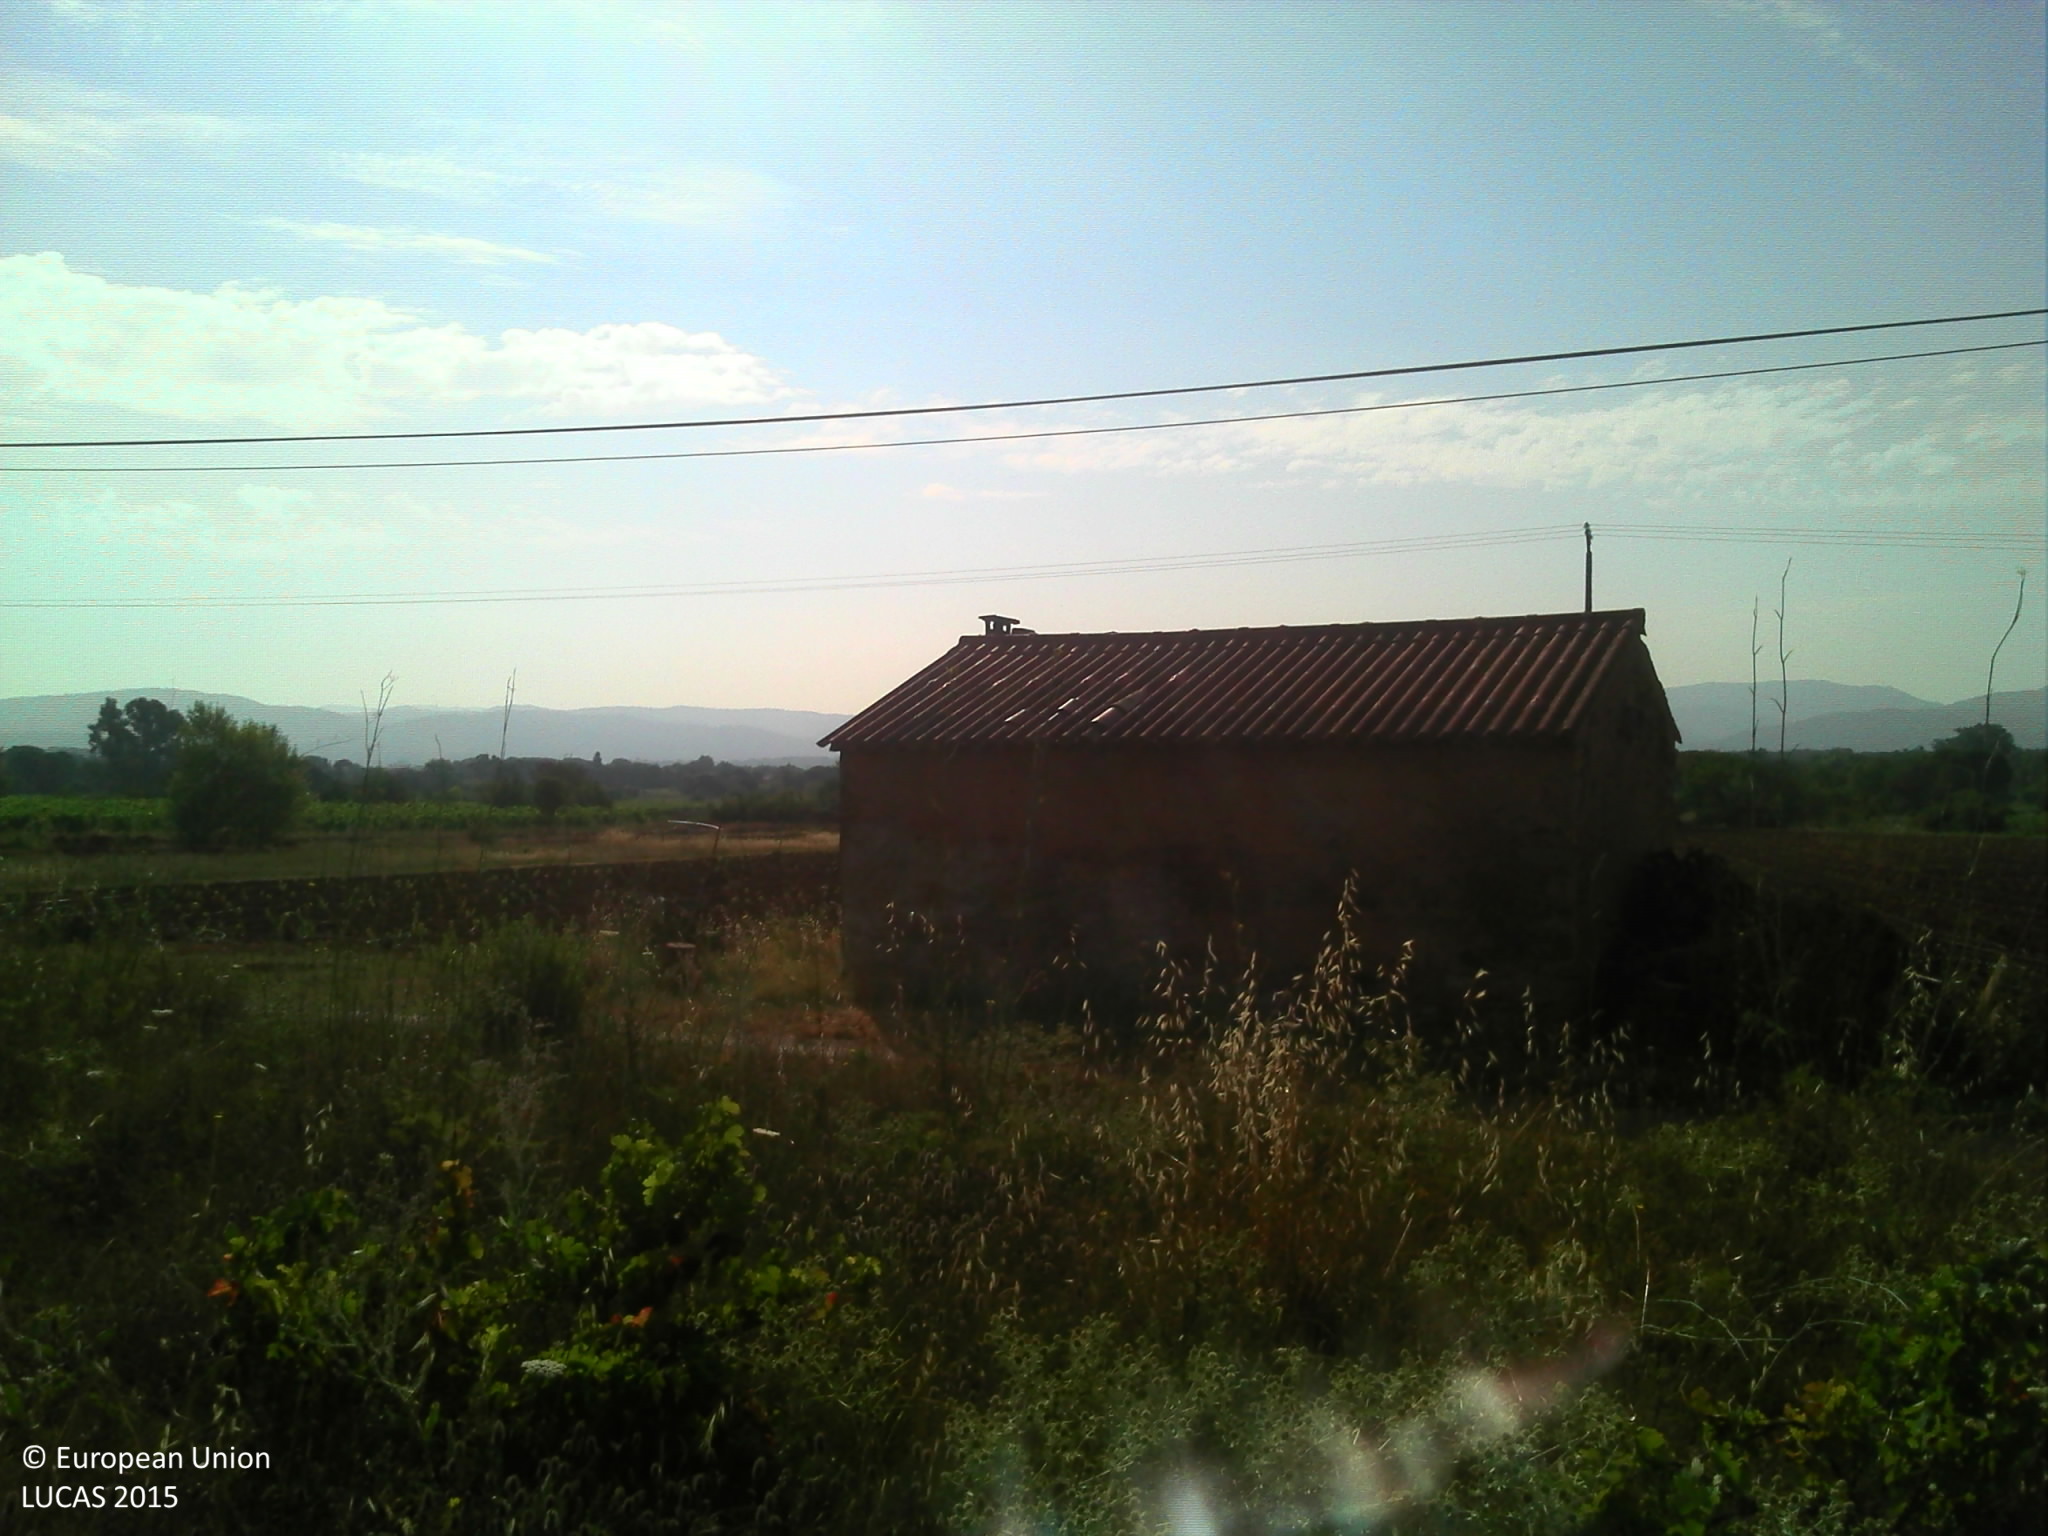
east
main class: Cropland
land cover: Vineyards
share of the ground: 25 - 50 %
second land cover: Grassland without tree/shrub cover
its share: > 75 %
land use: Abandoned areas
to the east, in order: Vineyards; Grassland without tree/shrub cover; Electric lines; Ditches and canals; Paved roads, cycling and walking lanes; Grass margins; Vineyards; Grassland without tree/shrub cover; Other bare soil; Vineyards; Grass margins; Lines of trees; Ditches and canals; Tracks; Ditches and canals; Abandoned hedges; Vineyards
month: July
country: FR
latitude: 43.4038
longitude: 6.4156
